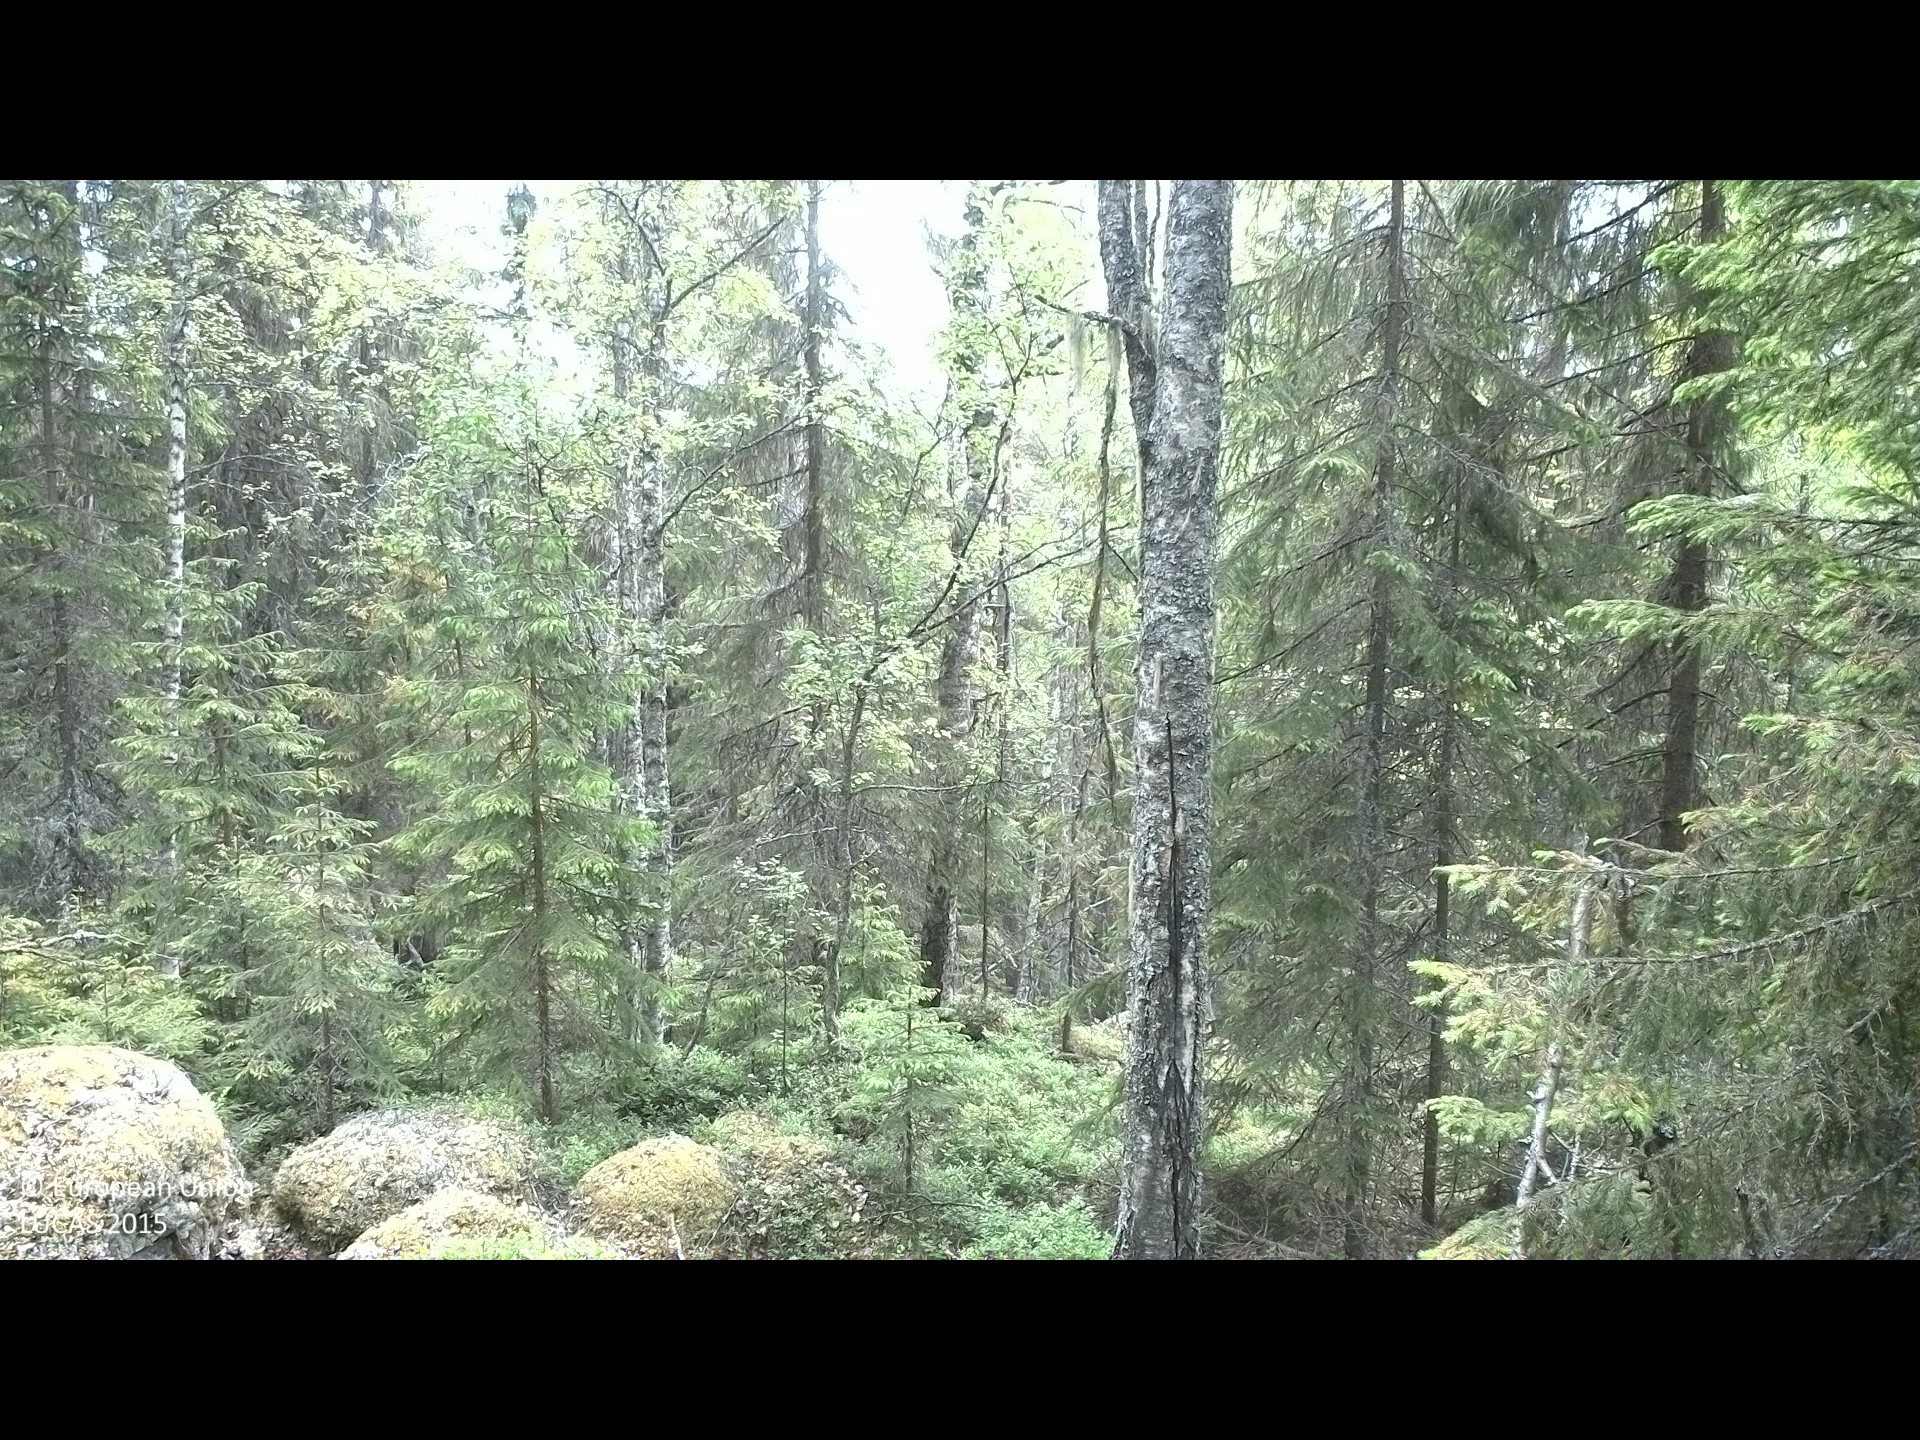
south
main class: Woodland
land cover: Spruce dominated mixed woodland
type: boreal forest
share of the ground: 25 - 50 %
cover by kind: lichens and mosses 35 %, shrubs 30 %, coniferous forest trees 20 %, broadleaved forest trees 15 %
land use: Forestry
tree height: > 5 m
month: June
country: SE
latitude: 61.9774
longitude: 16.2208
